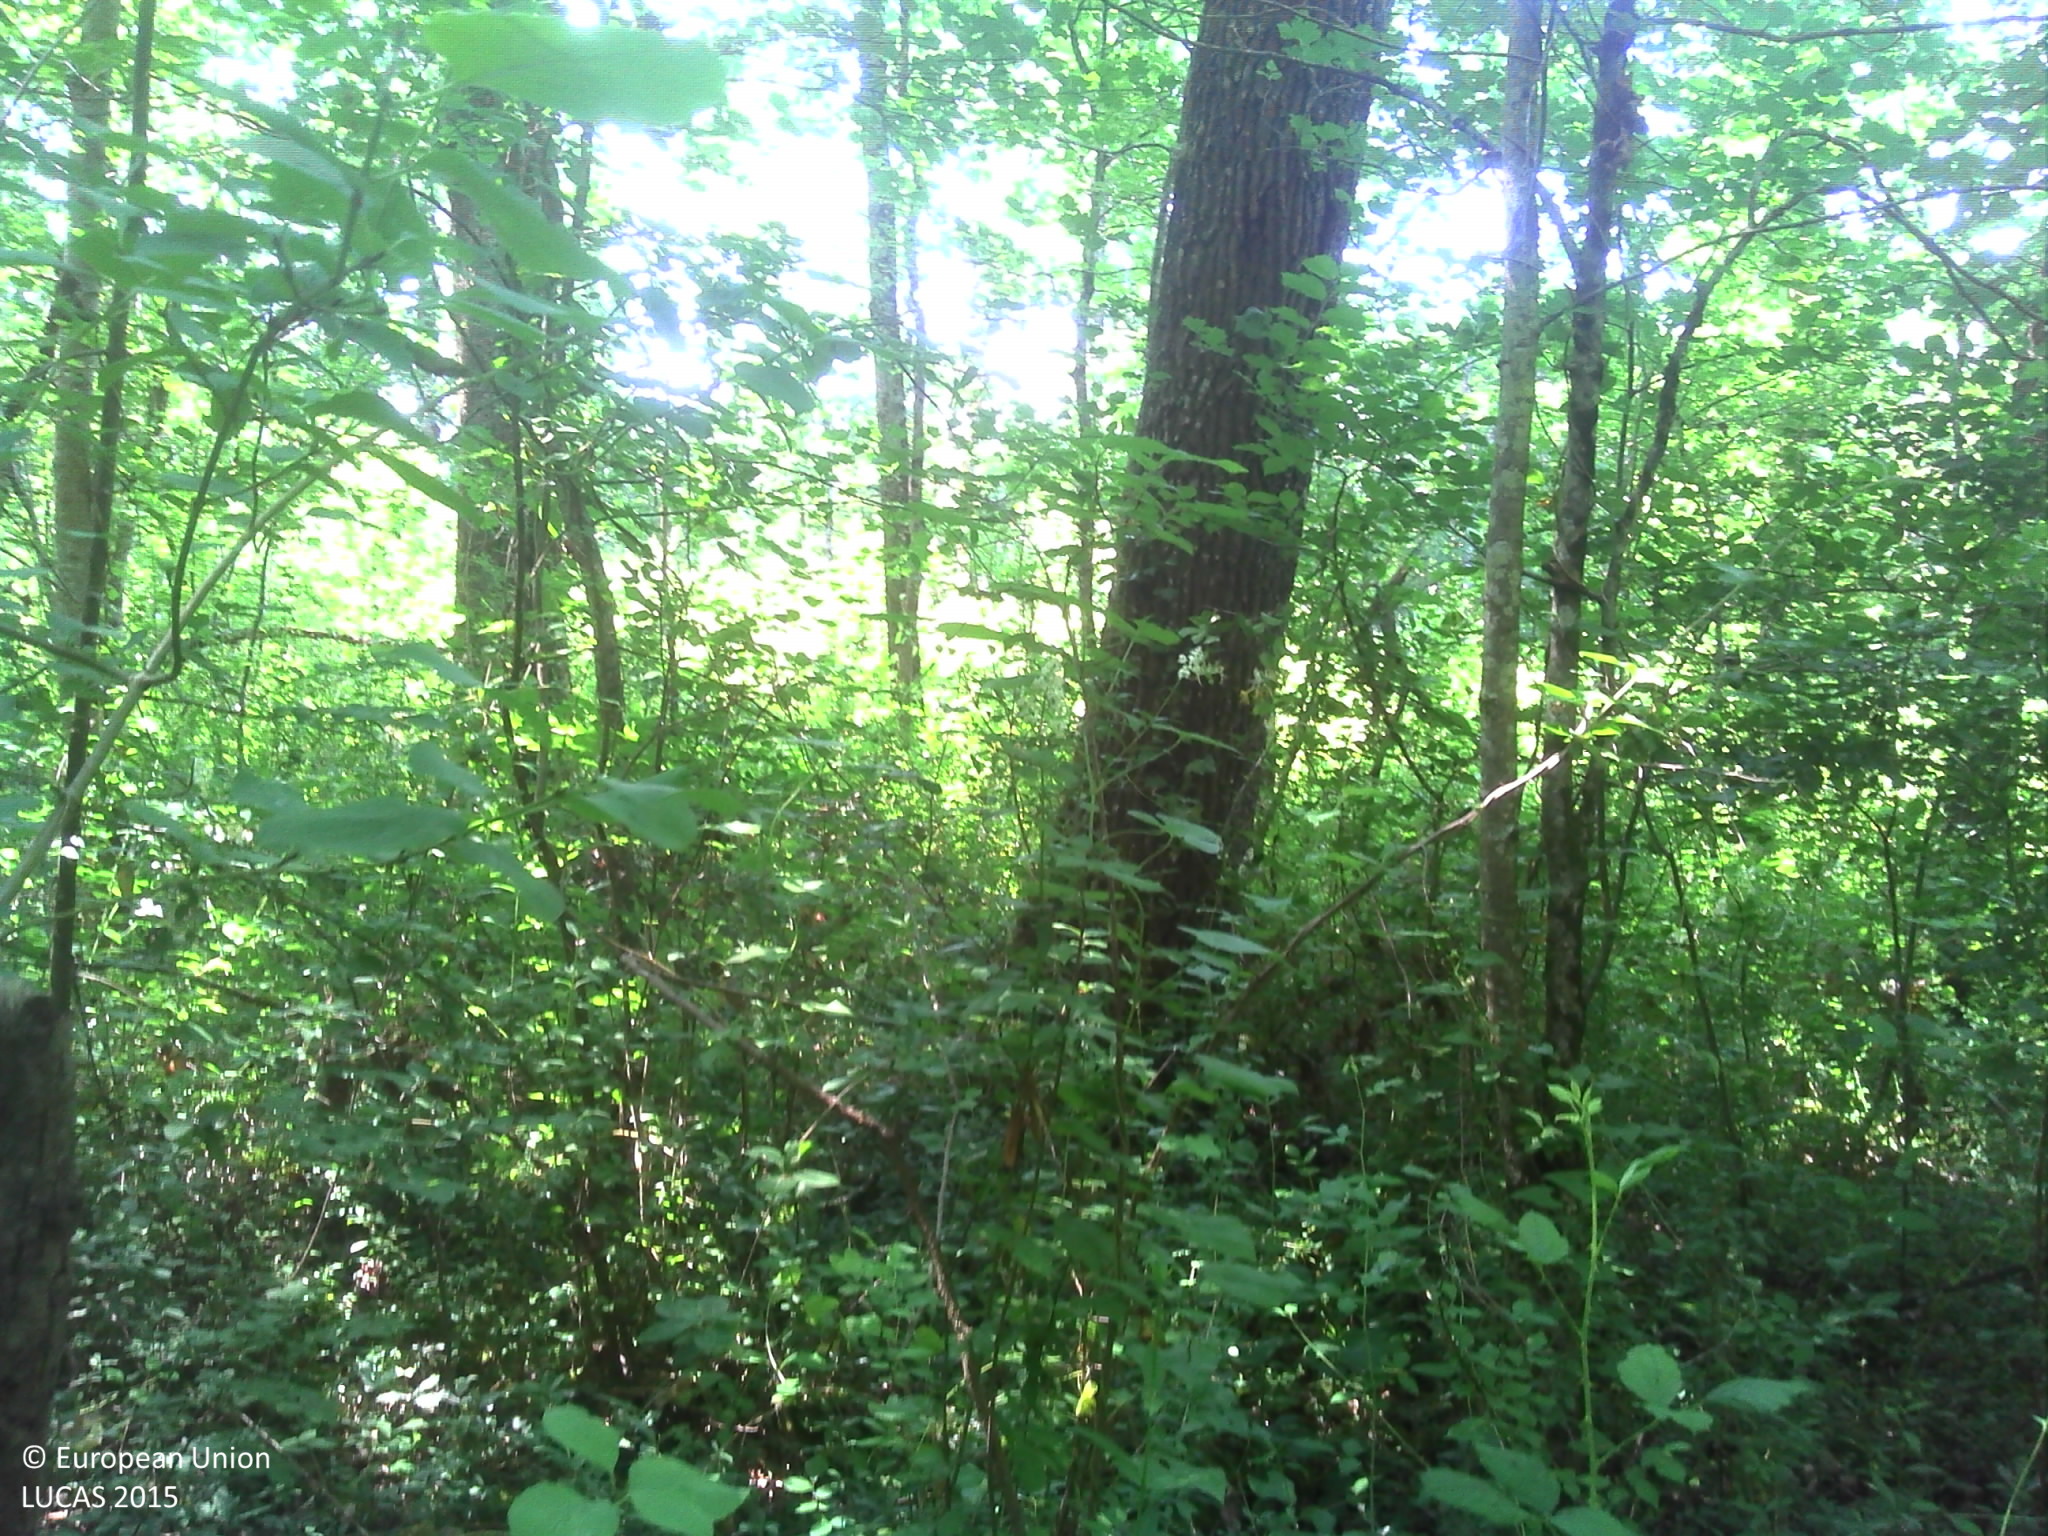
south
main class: Woodland
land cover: Broadleaved woodland
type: mesophytic deciduous forest
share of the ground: > 75 %
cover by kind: broadleaved forest trees 100 %
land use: Forestry
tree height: > 5 m
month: June
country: FR
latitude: 43.8566
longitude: 1.9542
